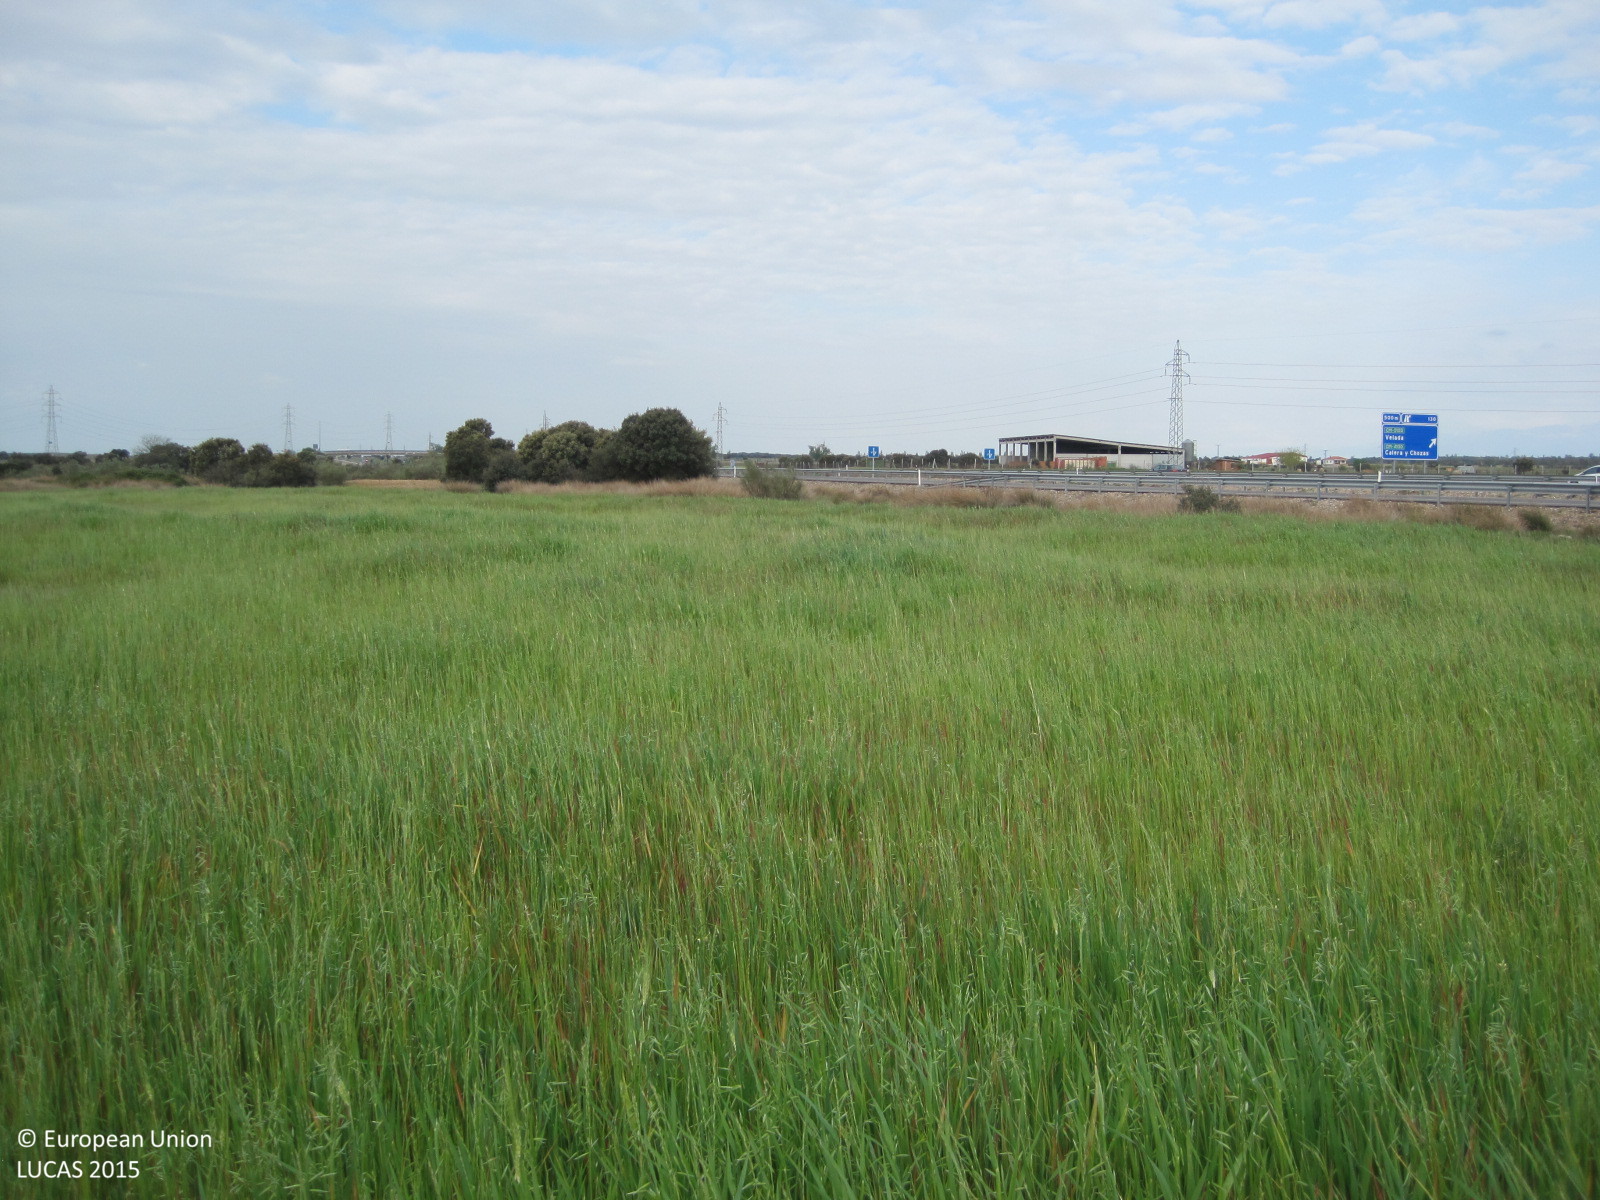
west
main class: Cropland
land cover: Mixed cereals for fodder
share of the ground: > 75 %
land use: Agriculture (excluding fallow land and kitchen gardens)
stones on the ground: 25 - 50 %
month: April
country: ES
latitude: 39.9378
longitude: -4.9706
